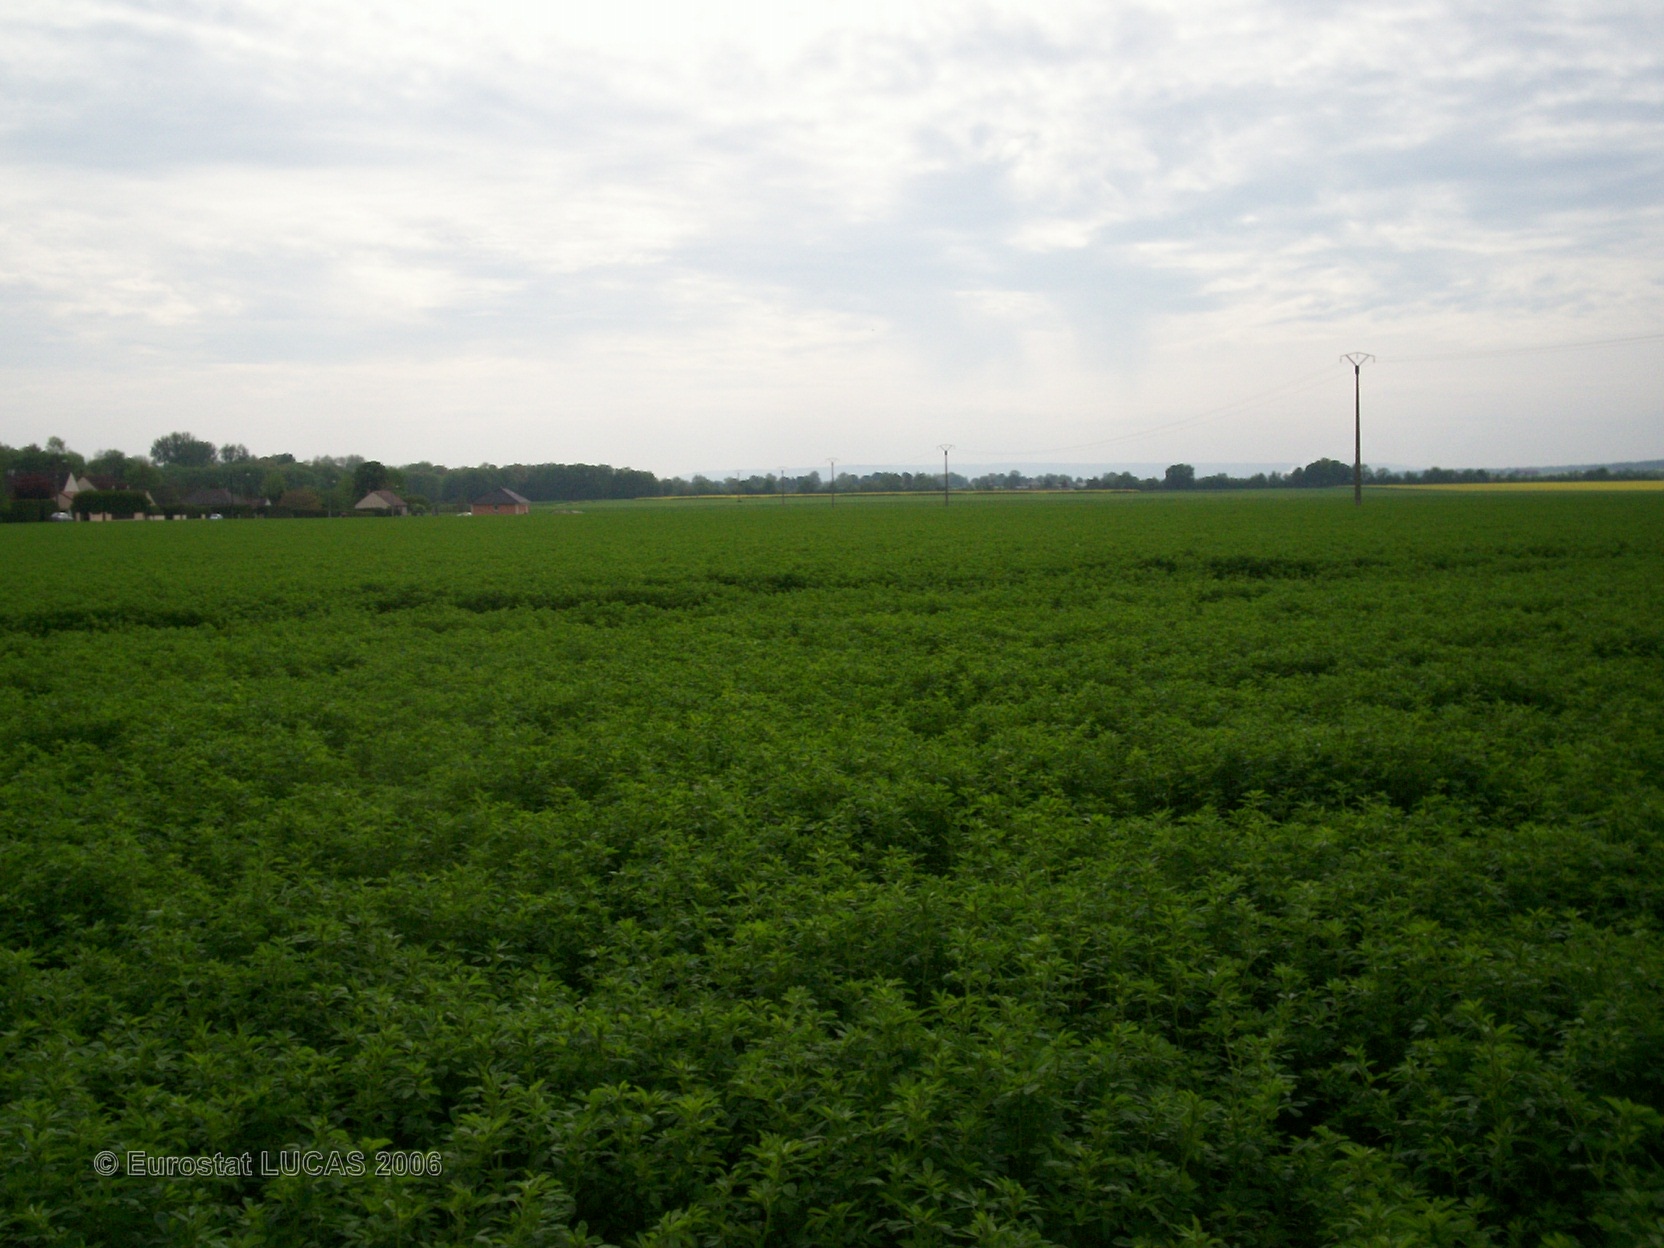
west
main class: Cropland
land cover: Lucerne
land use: Agriculture (excluding fallow land and kitchen gardens)
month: May
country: FR
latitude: 49.1433
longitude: 4.3620
